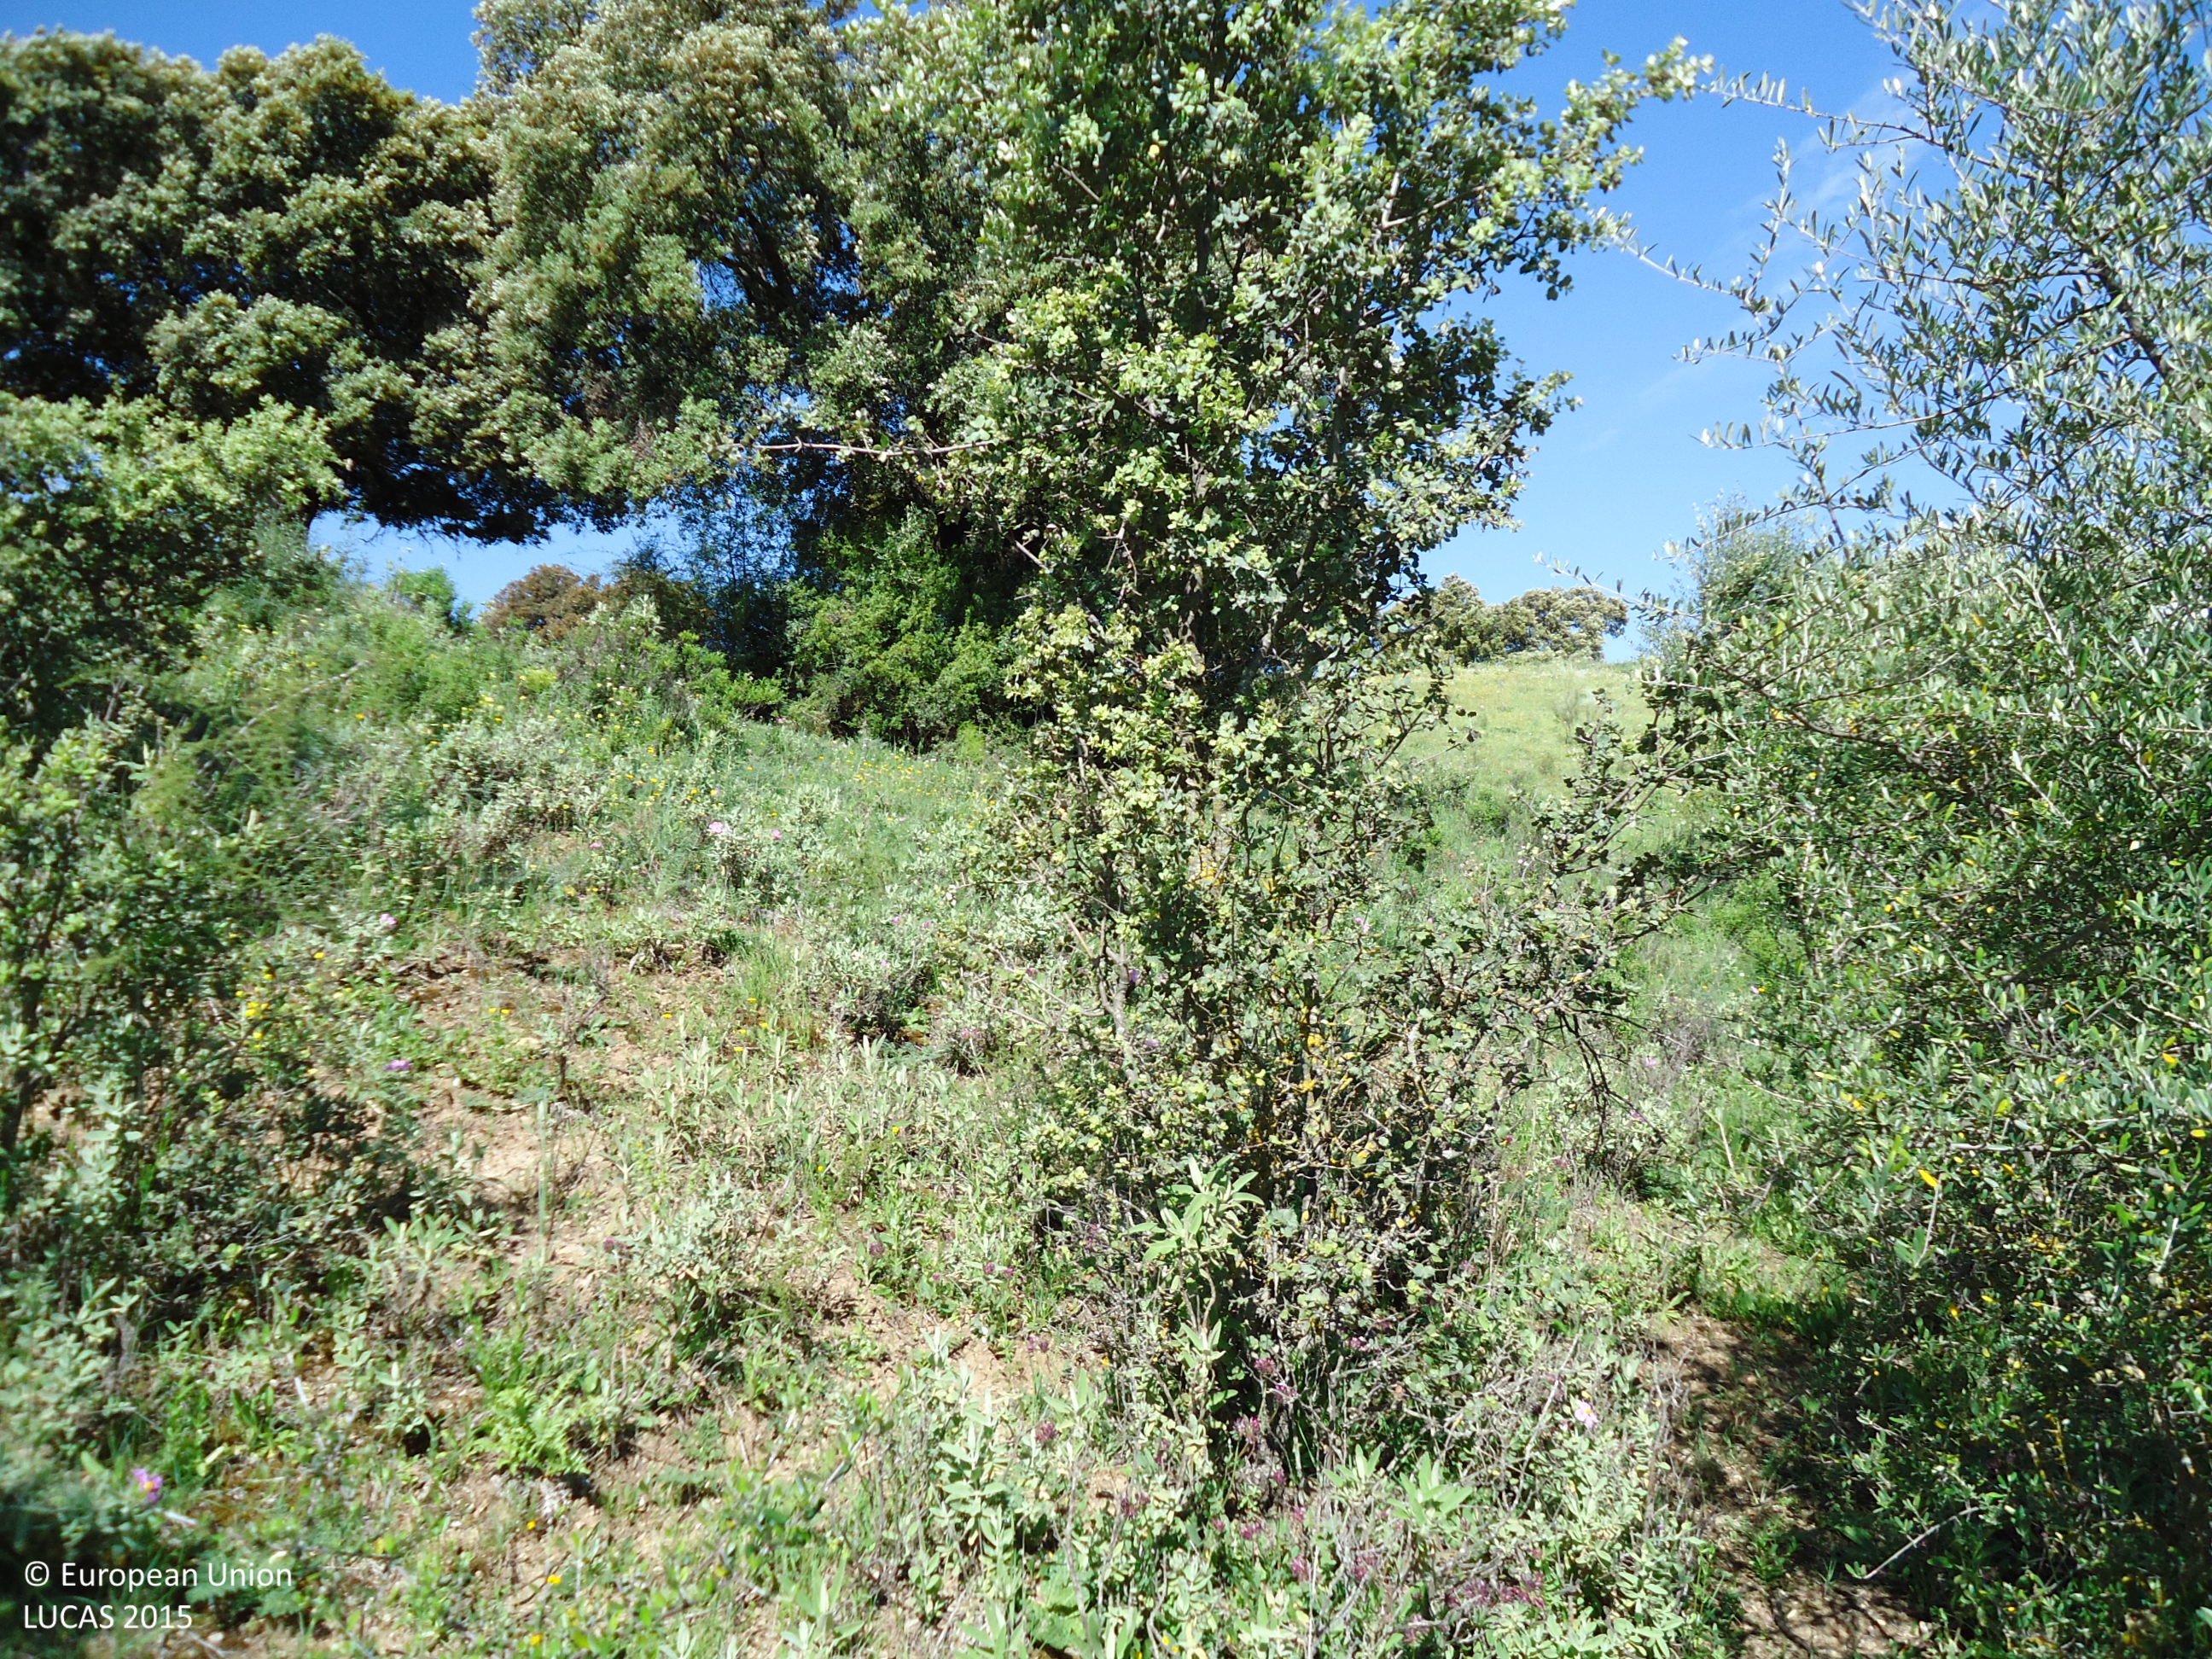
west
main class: Shrubland
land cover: Shrubland with sparse tree cover
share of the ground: 50 - 75 %
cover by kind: shrubs 70 %, herbaceous plants 25 %, broadleaved forest trees 5 %
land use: Agriculture (excluding fallow land and kitchen gardens)
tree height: > 5 m
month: April
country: ES
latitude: 36.9348
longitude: -5.3533
